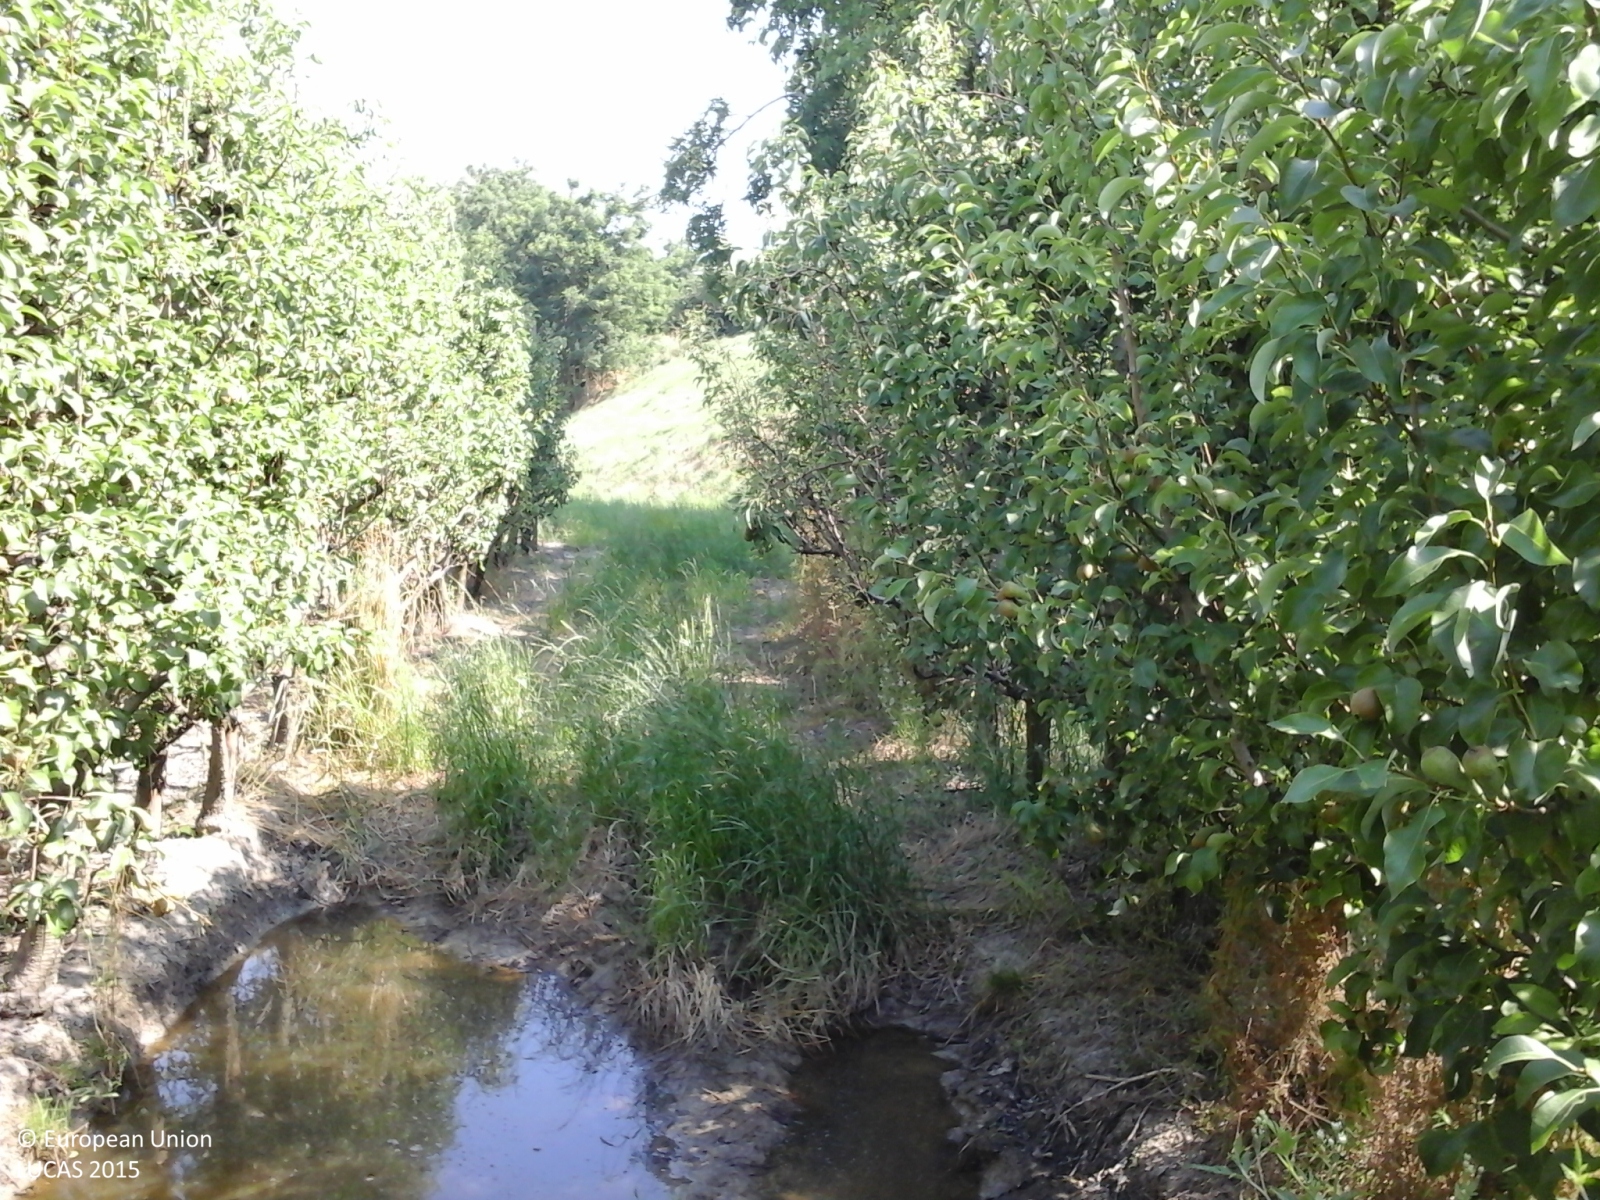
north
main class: Cropland
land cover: Pear fruit
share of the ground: 25 - 50 %
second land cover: Grassland without tree/shrub cover
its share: 25 - 50 %
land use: Agriculture (excluding fallow land and kitchen gardens)
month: June
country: IT
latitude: 44.6429
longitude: 11.7237
